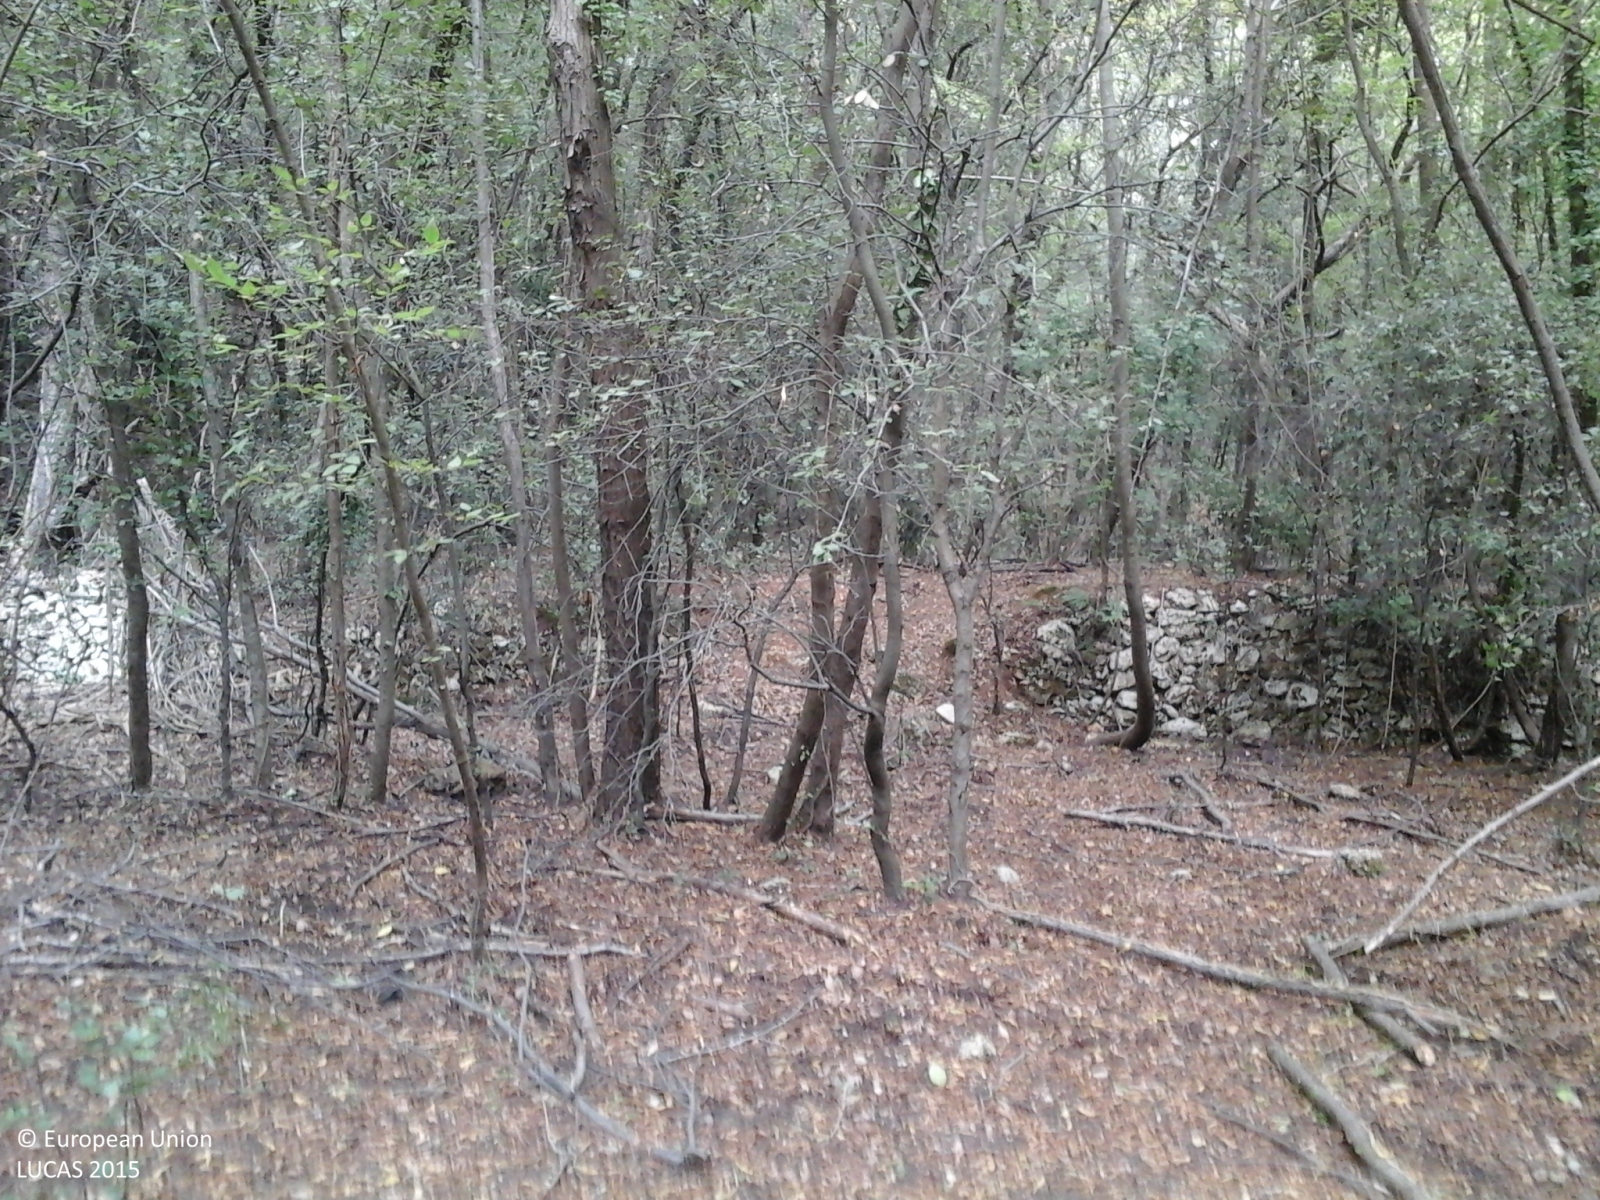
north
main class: Woodland
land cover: Broadleaved woodland
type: thermophilous deciduous forest
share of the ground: > 75 %
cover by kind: broadleaved forest trees 100 %
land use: Semi-natural and natural areas not in use
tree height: > 5 m
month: September
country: IT
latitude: 44.1930
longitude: 8.3398
